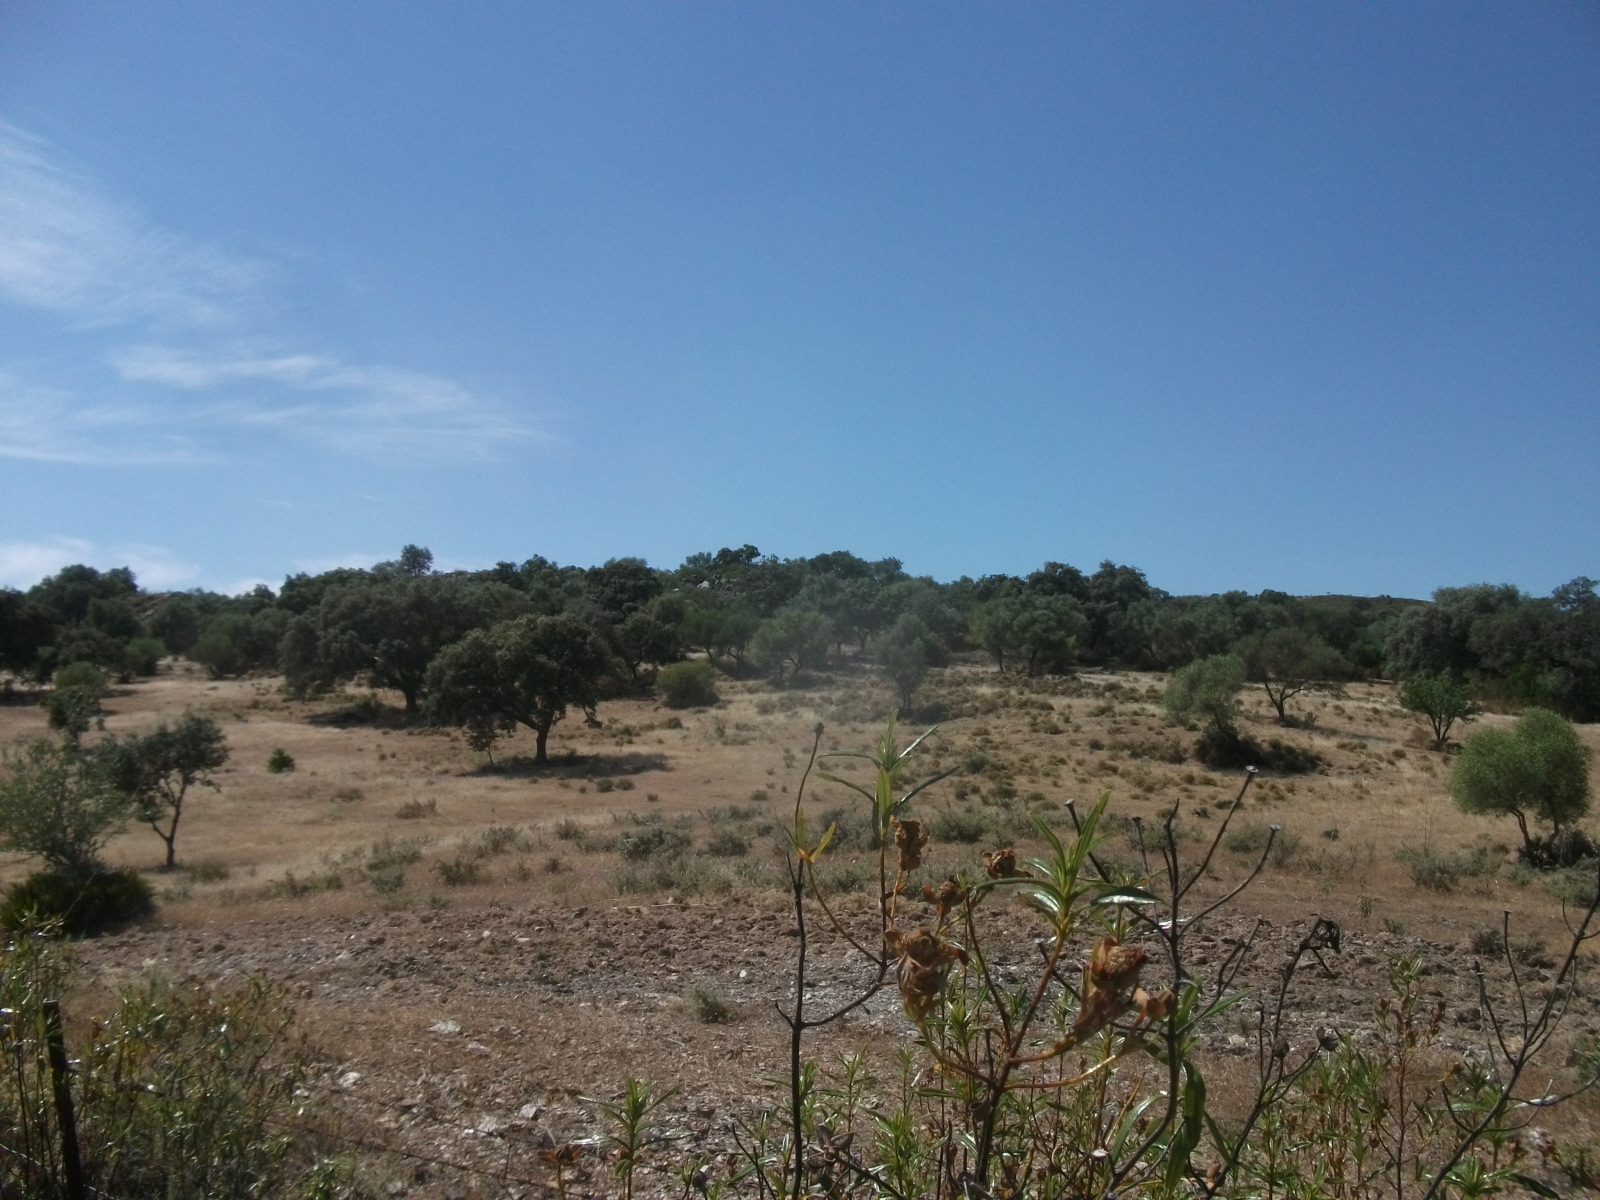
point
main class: Woodland
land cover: Broadleaved woodland
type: broadleaved evergreen forest
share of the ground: > 75 %
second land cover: Spontaneously vegetated surfaces
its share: < 10 %
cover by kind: broadleaved forest trees 80 %, shrubs 10 %, herbaceous plants 10 %
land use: Forestry
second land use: Agriculture (excluding fallow land and kitchen gardens)
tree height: > 5 m
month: June
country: ES
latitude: 37.7179
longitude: -7.0088
